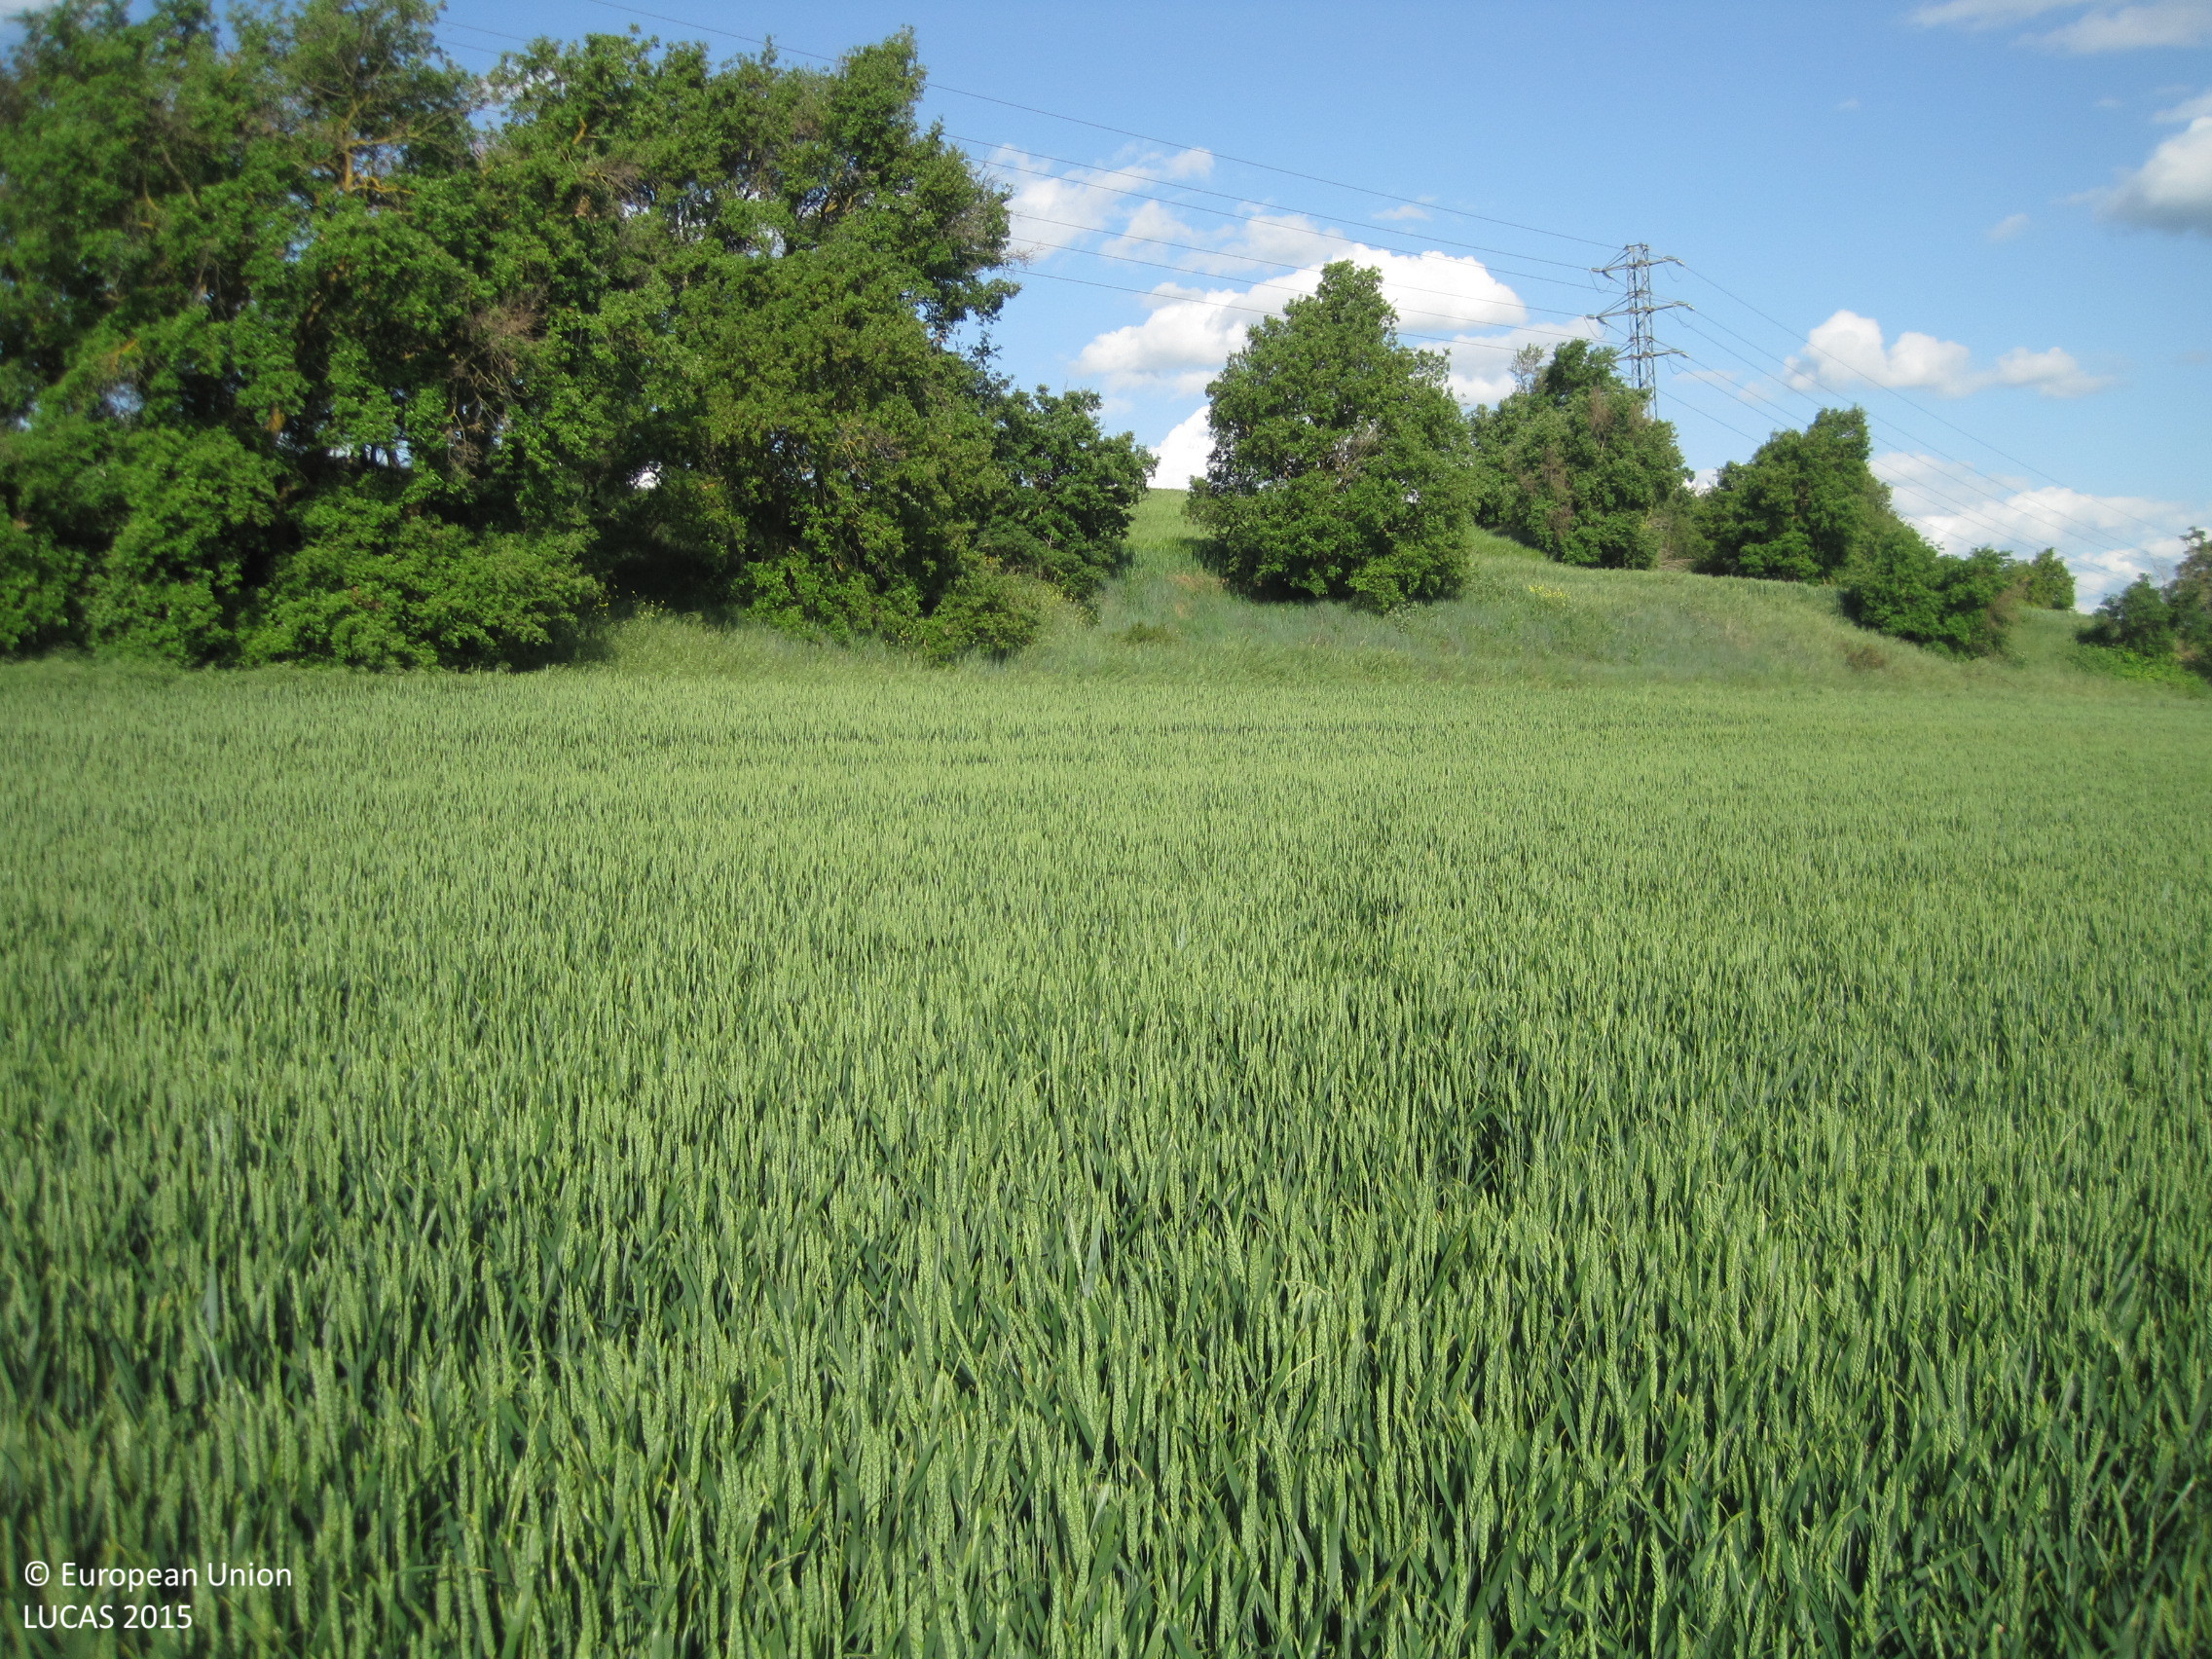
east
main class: Cropland
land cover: Common wheat
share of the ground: > 75 %
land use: Agriculture (excluding fallow land and kitchen gardens)
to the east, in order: Common wheat; Broadleaved woodland; Barley; Electric lines; Barley; Tracks; Broadleaved woodland; Common wheat; Broadleaved woodland
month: May
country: ES
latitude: 42.6316
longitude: -1.6833
